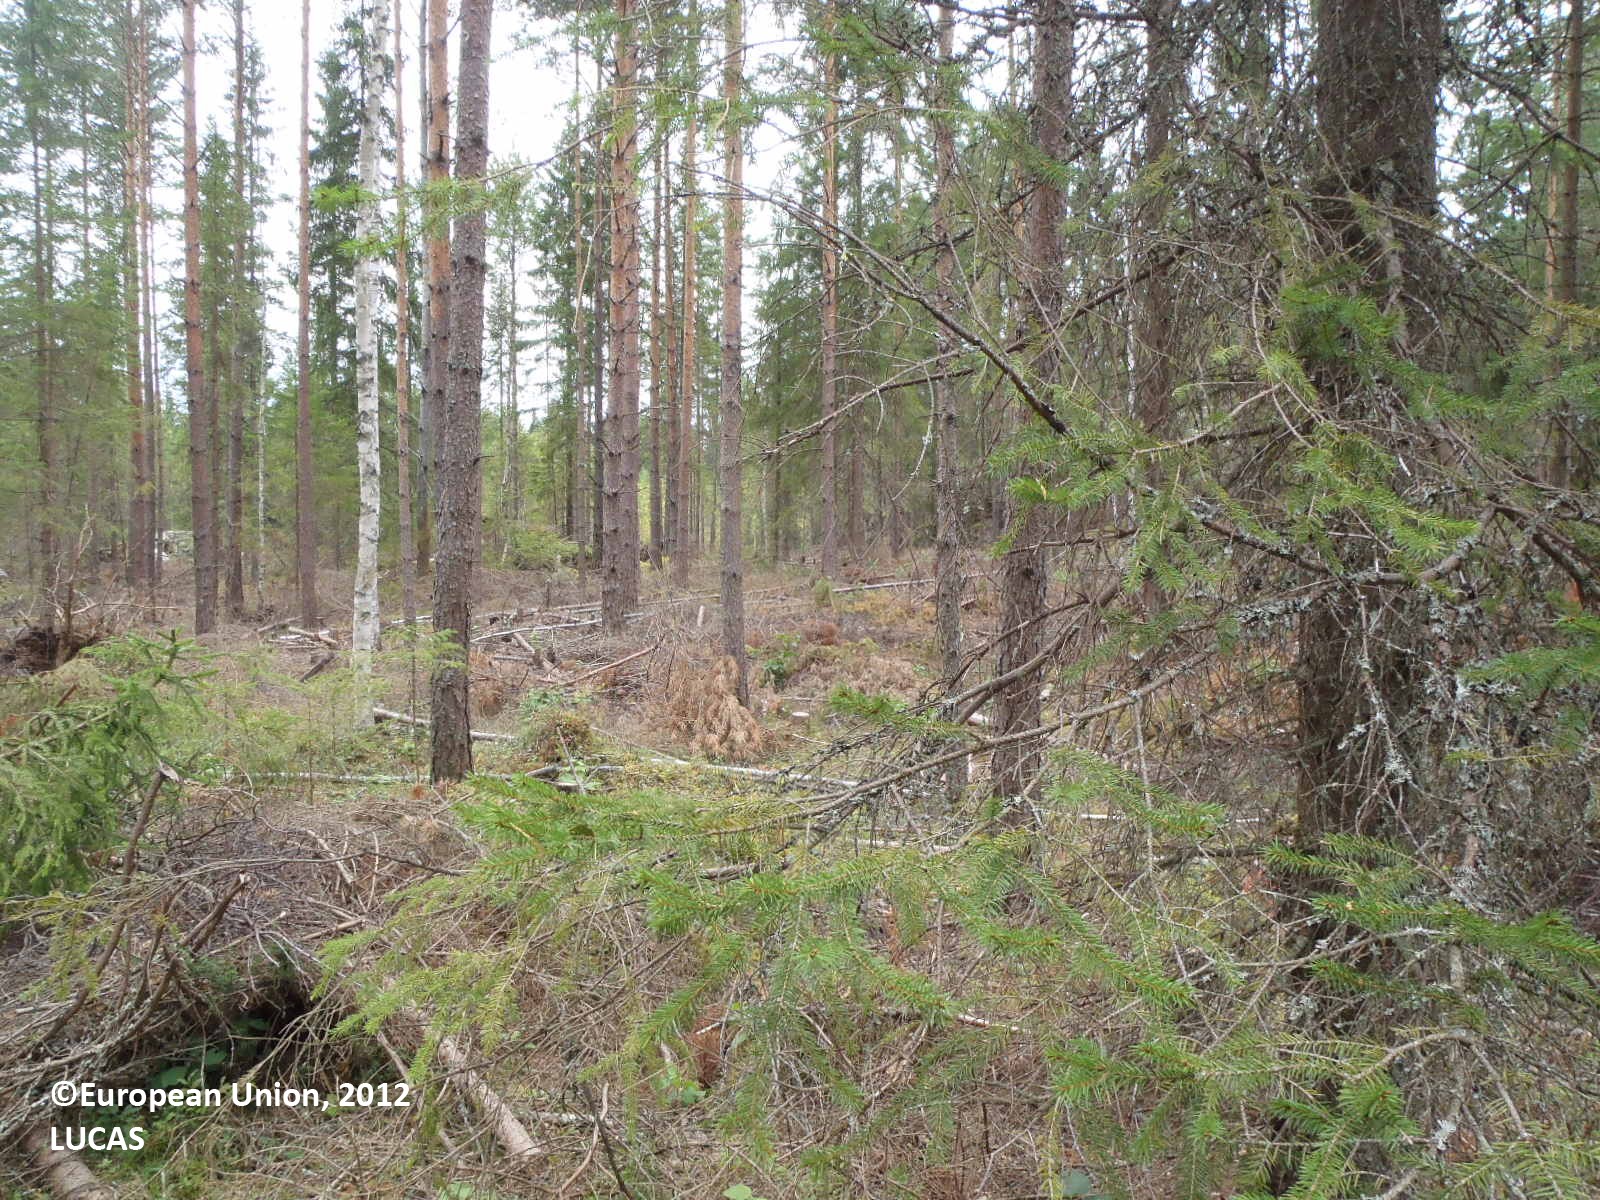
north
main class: Woodland
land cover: Pine dominated mixed woodland
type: boreal forest
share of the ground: > 75 %
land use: Forestry
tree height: > 5 m
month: August
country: FI
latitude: 60.8145
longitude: 22.4396
